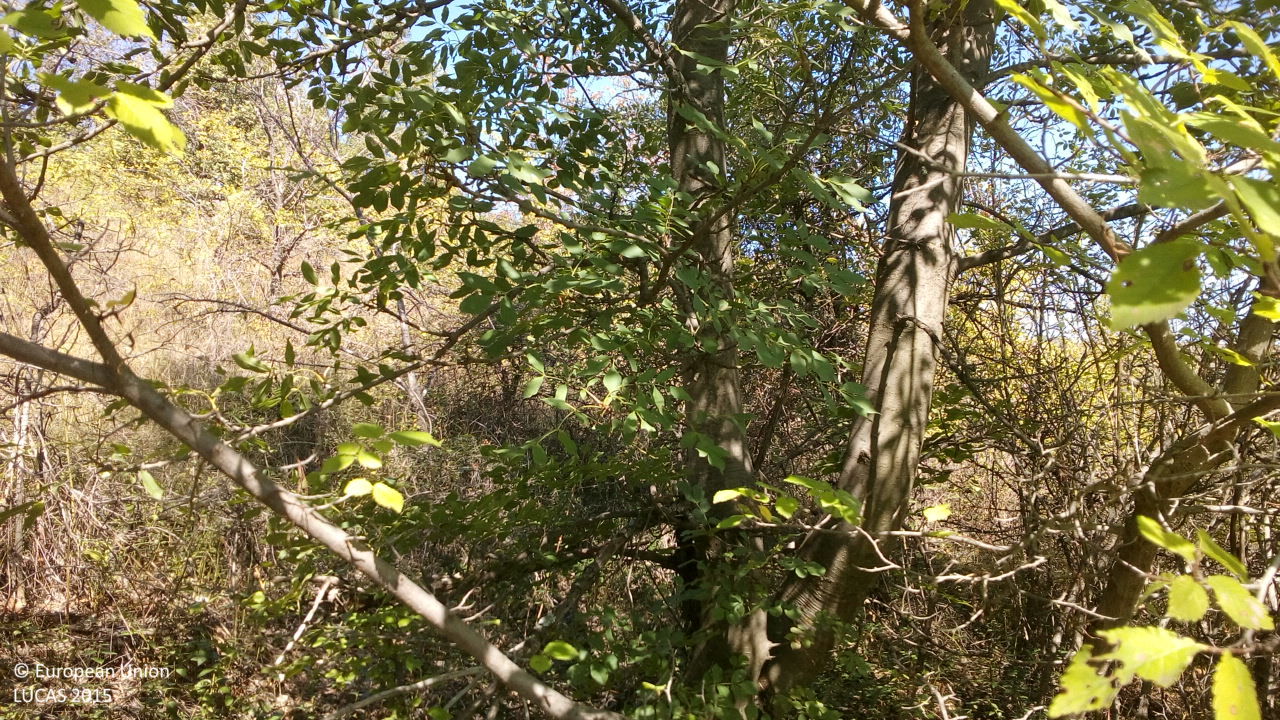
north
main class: Woodland
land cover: Broadleaved woodland
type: thermophilous deciduous forest
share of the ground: > 75 %
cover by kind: broadleaved forest trees 95 %, unconsolidated bare surface 5 %
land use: Forestry
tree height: < 5 m
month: October
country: BG
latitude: 42.0545
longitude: 22.9639
